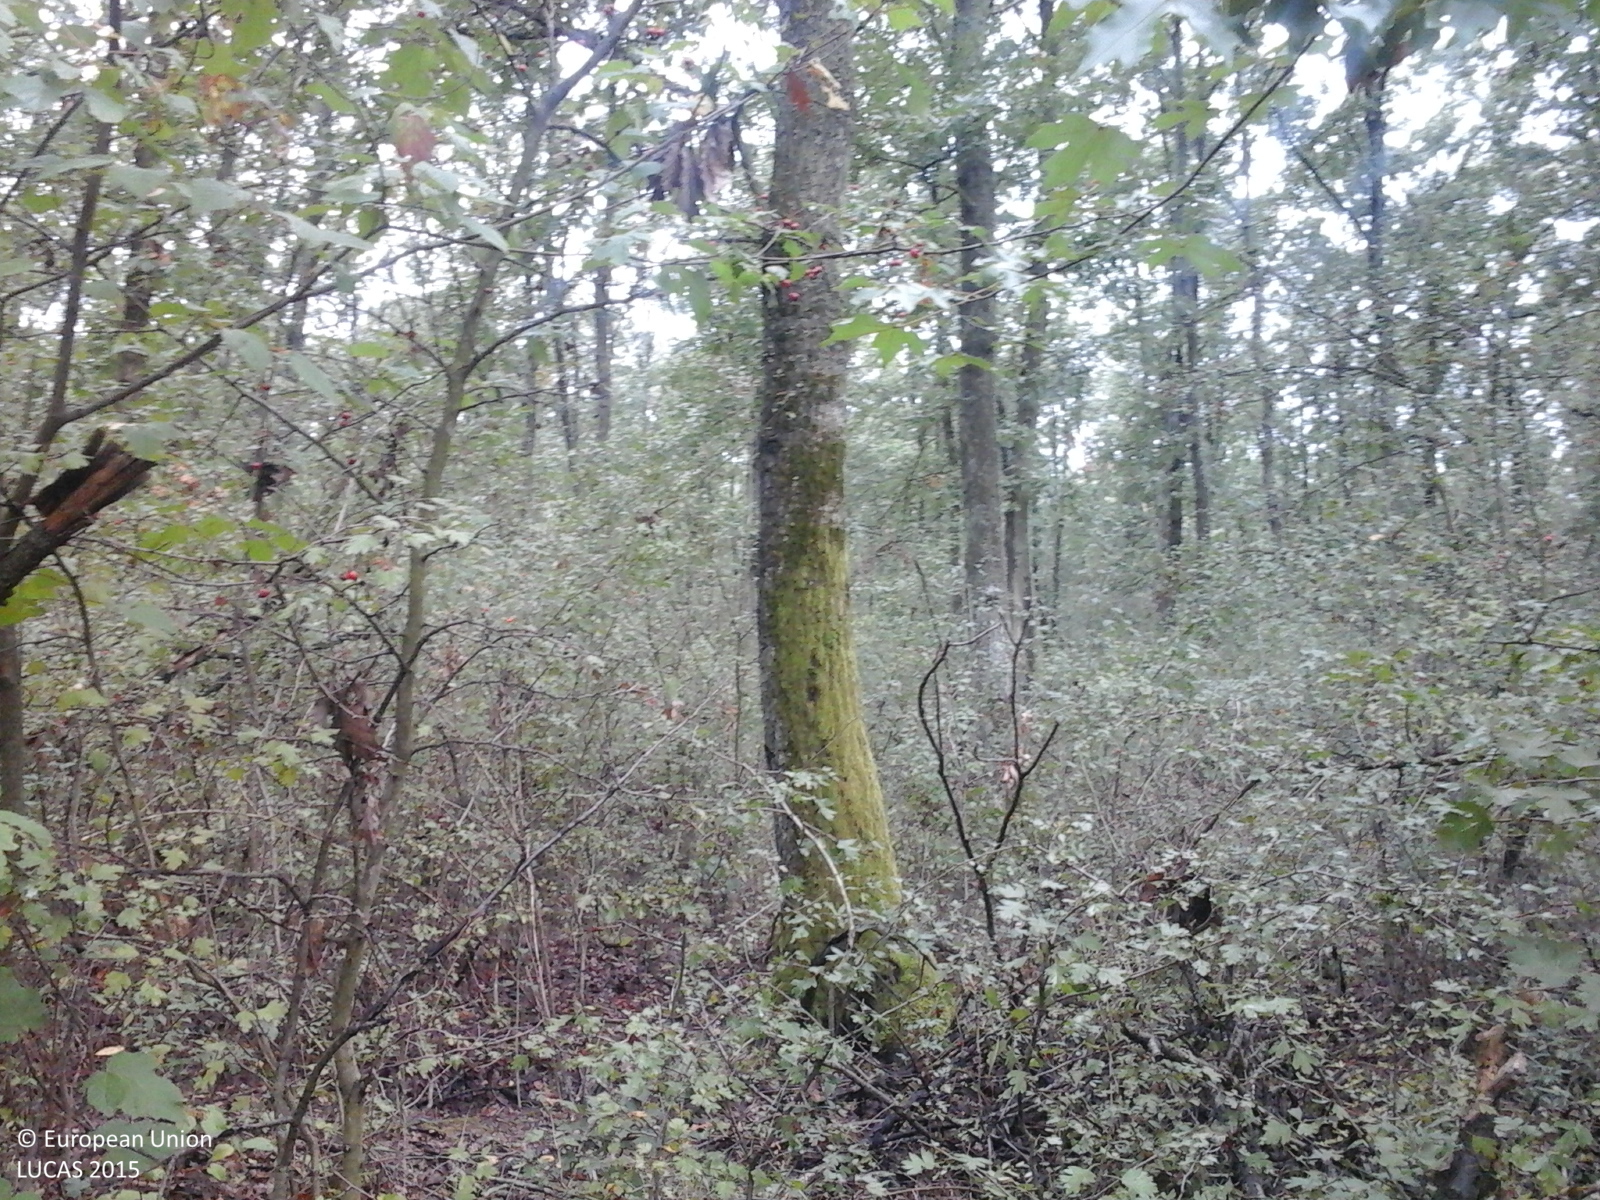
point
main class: Woodland
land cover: Broadleaved woodland
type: acidophilous oak and oak-birch forest
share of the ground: > 75 %
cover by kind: broadleaved forest trees 80 %, shrubs 10 %, herbaceous plants 10 %
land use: Forestry
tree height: > 5 m
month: September
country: RO
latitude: 46.8027
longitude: 21.8232
